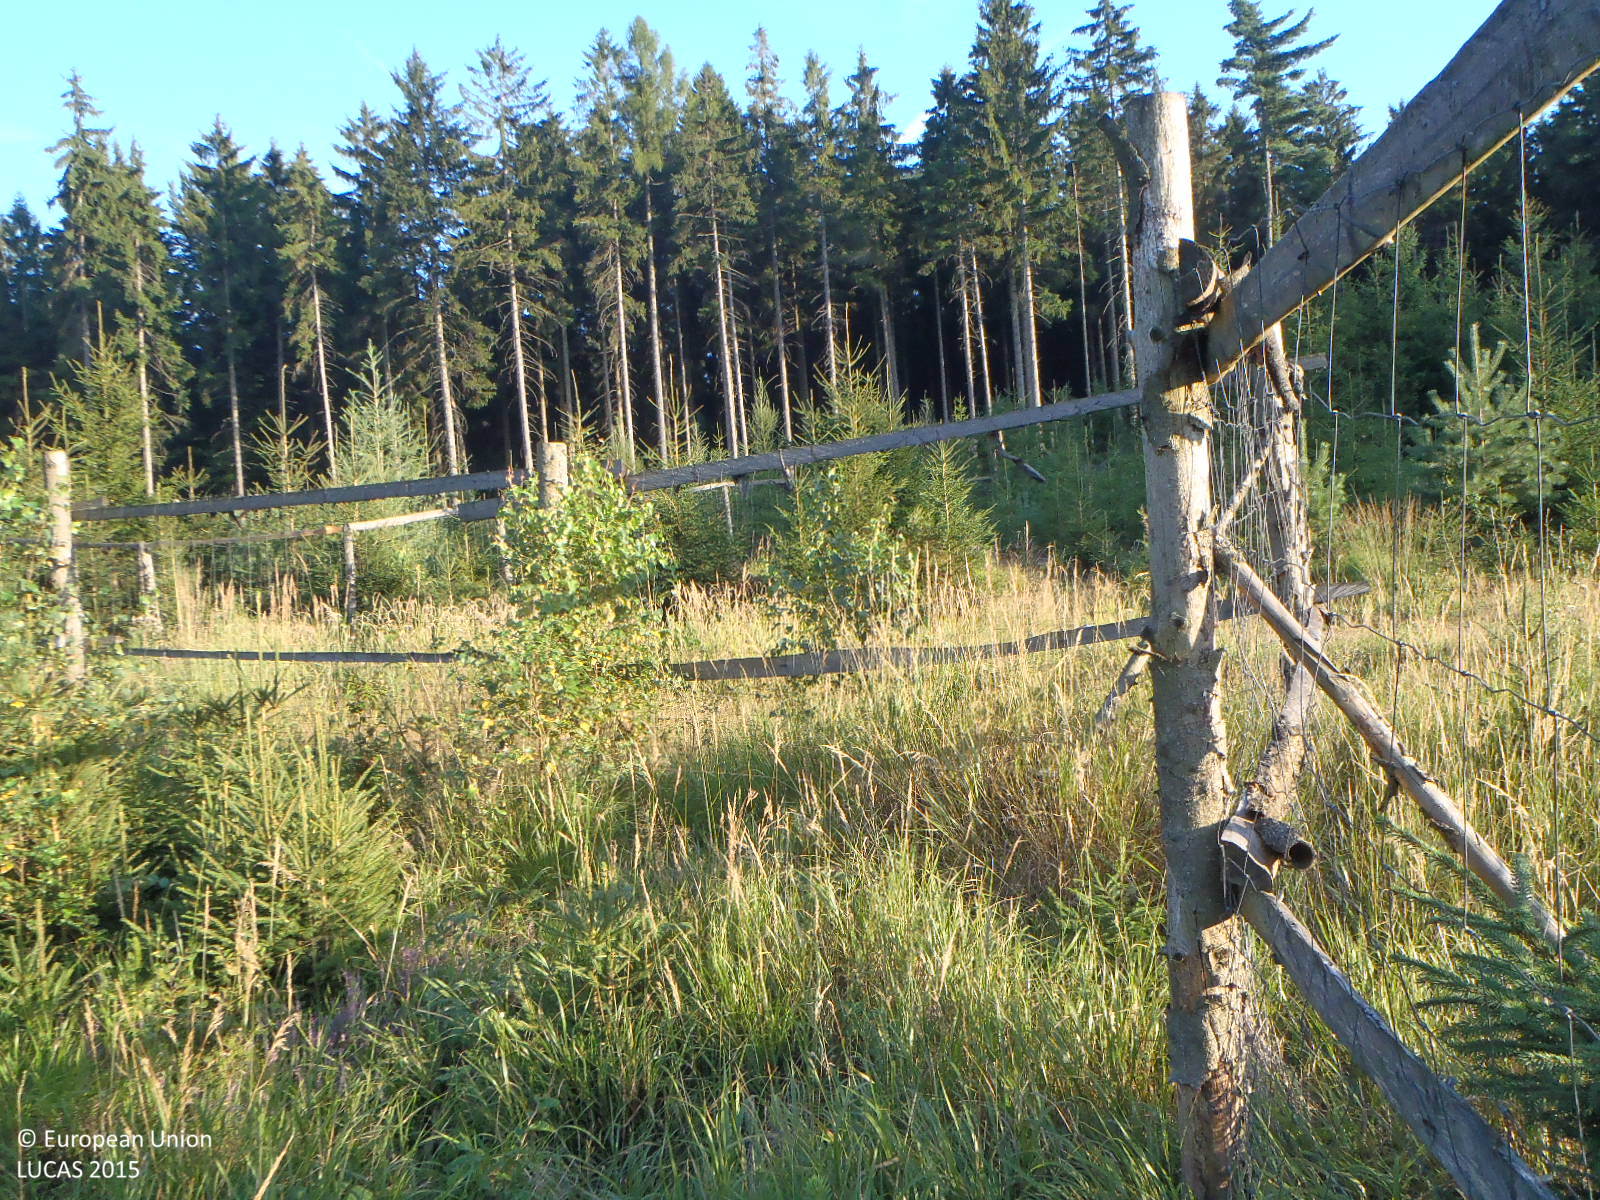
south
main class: Woodland
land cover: Other mixed woodland
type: hemiboreal forest and nemoral coniferous forest and mixed broadleaved-coniferous forest
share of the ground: 50 - 75 %
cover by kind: herbaceous plants 45 %, coniferous forest trees 25 %, broadleaved forest trees 25 %, shrubs 5 %
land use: Forestry
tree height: < 5 m
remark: Nursery
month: August
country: CZ
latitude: 50.8685
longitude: 14.5347
